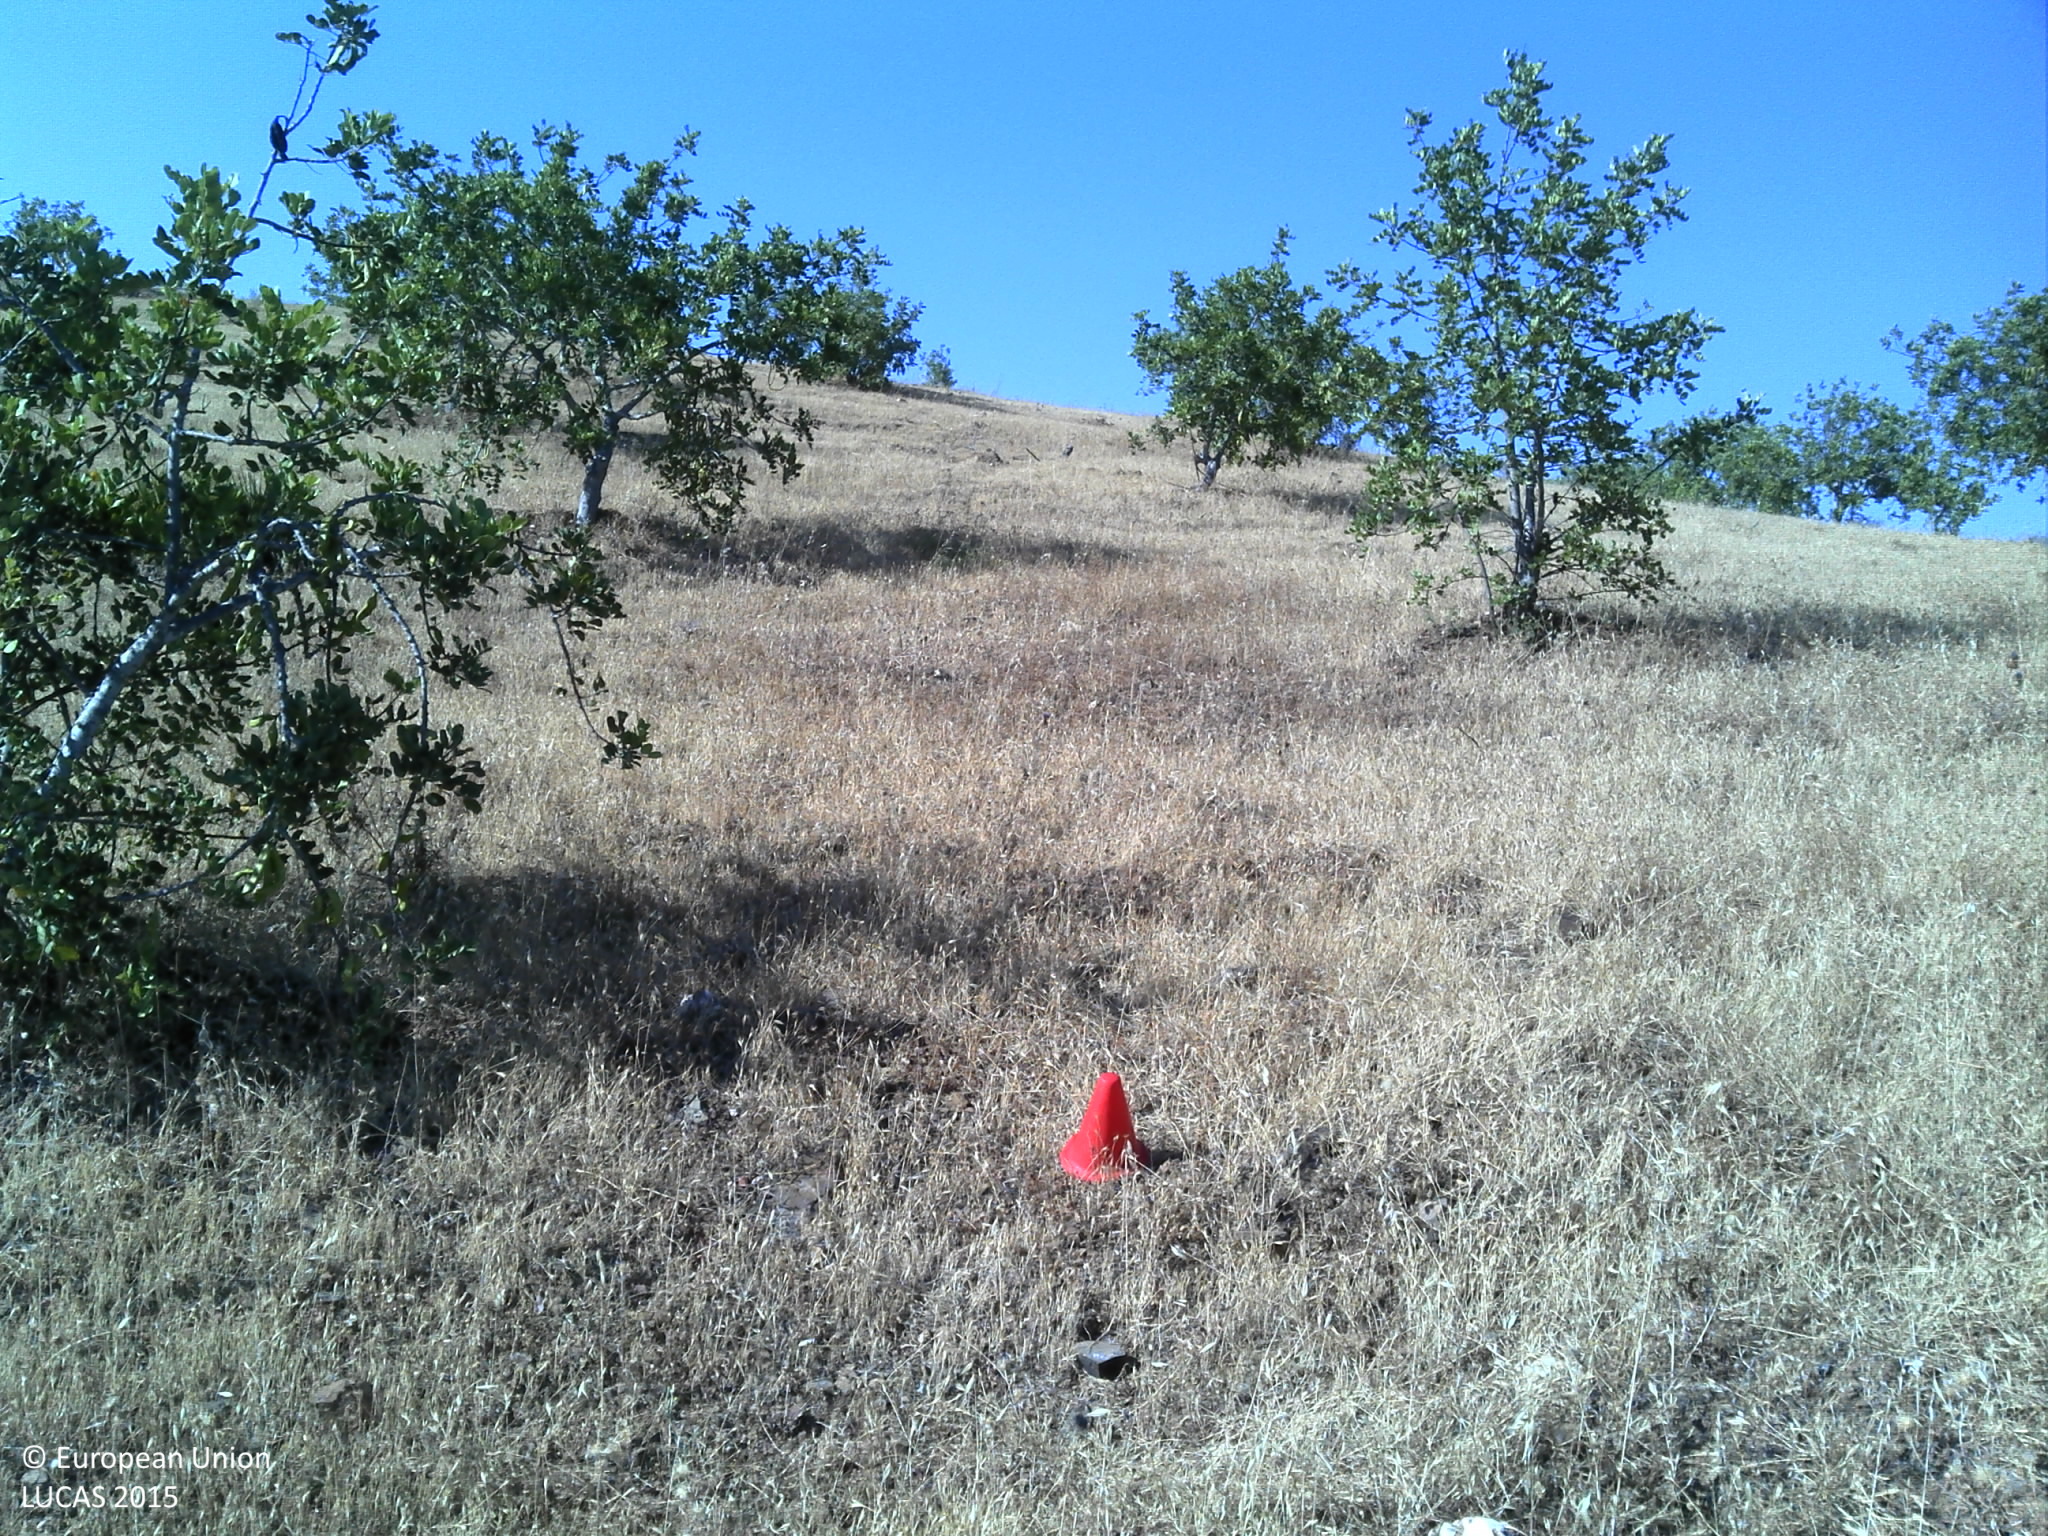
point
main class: Cropland
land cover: Permanent industrial crops
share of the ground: 25 - 50 %
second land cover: Spontaneously vegetated surfaces
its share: > 75 %
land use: Agriculture (excluding fallow land and kitchen gardens)
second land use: Other primary production
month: May
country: PT
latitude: 37.2240
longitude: -7.4833
